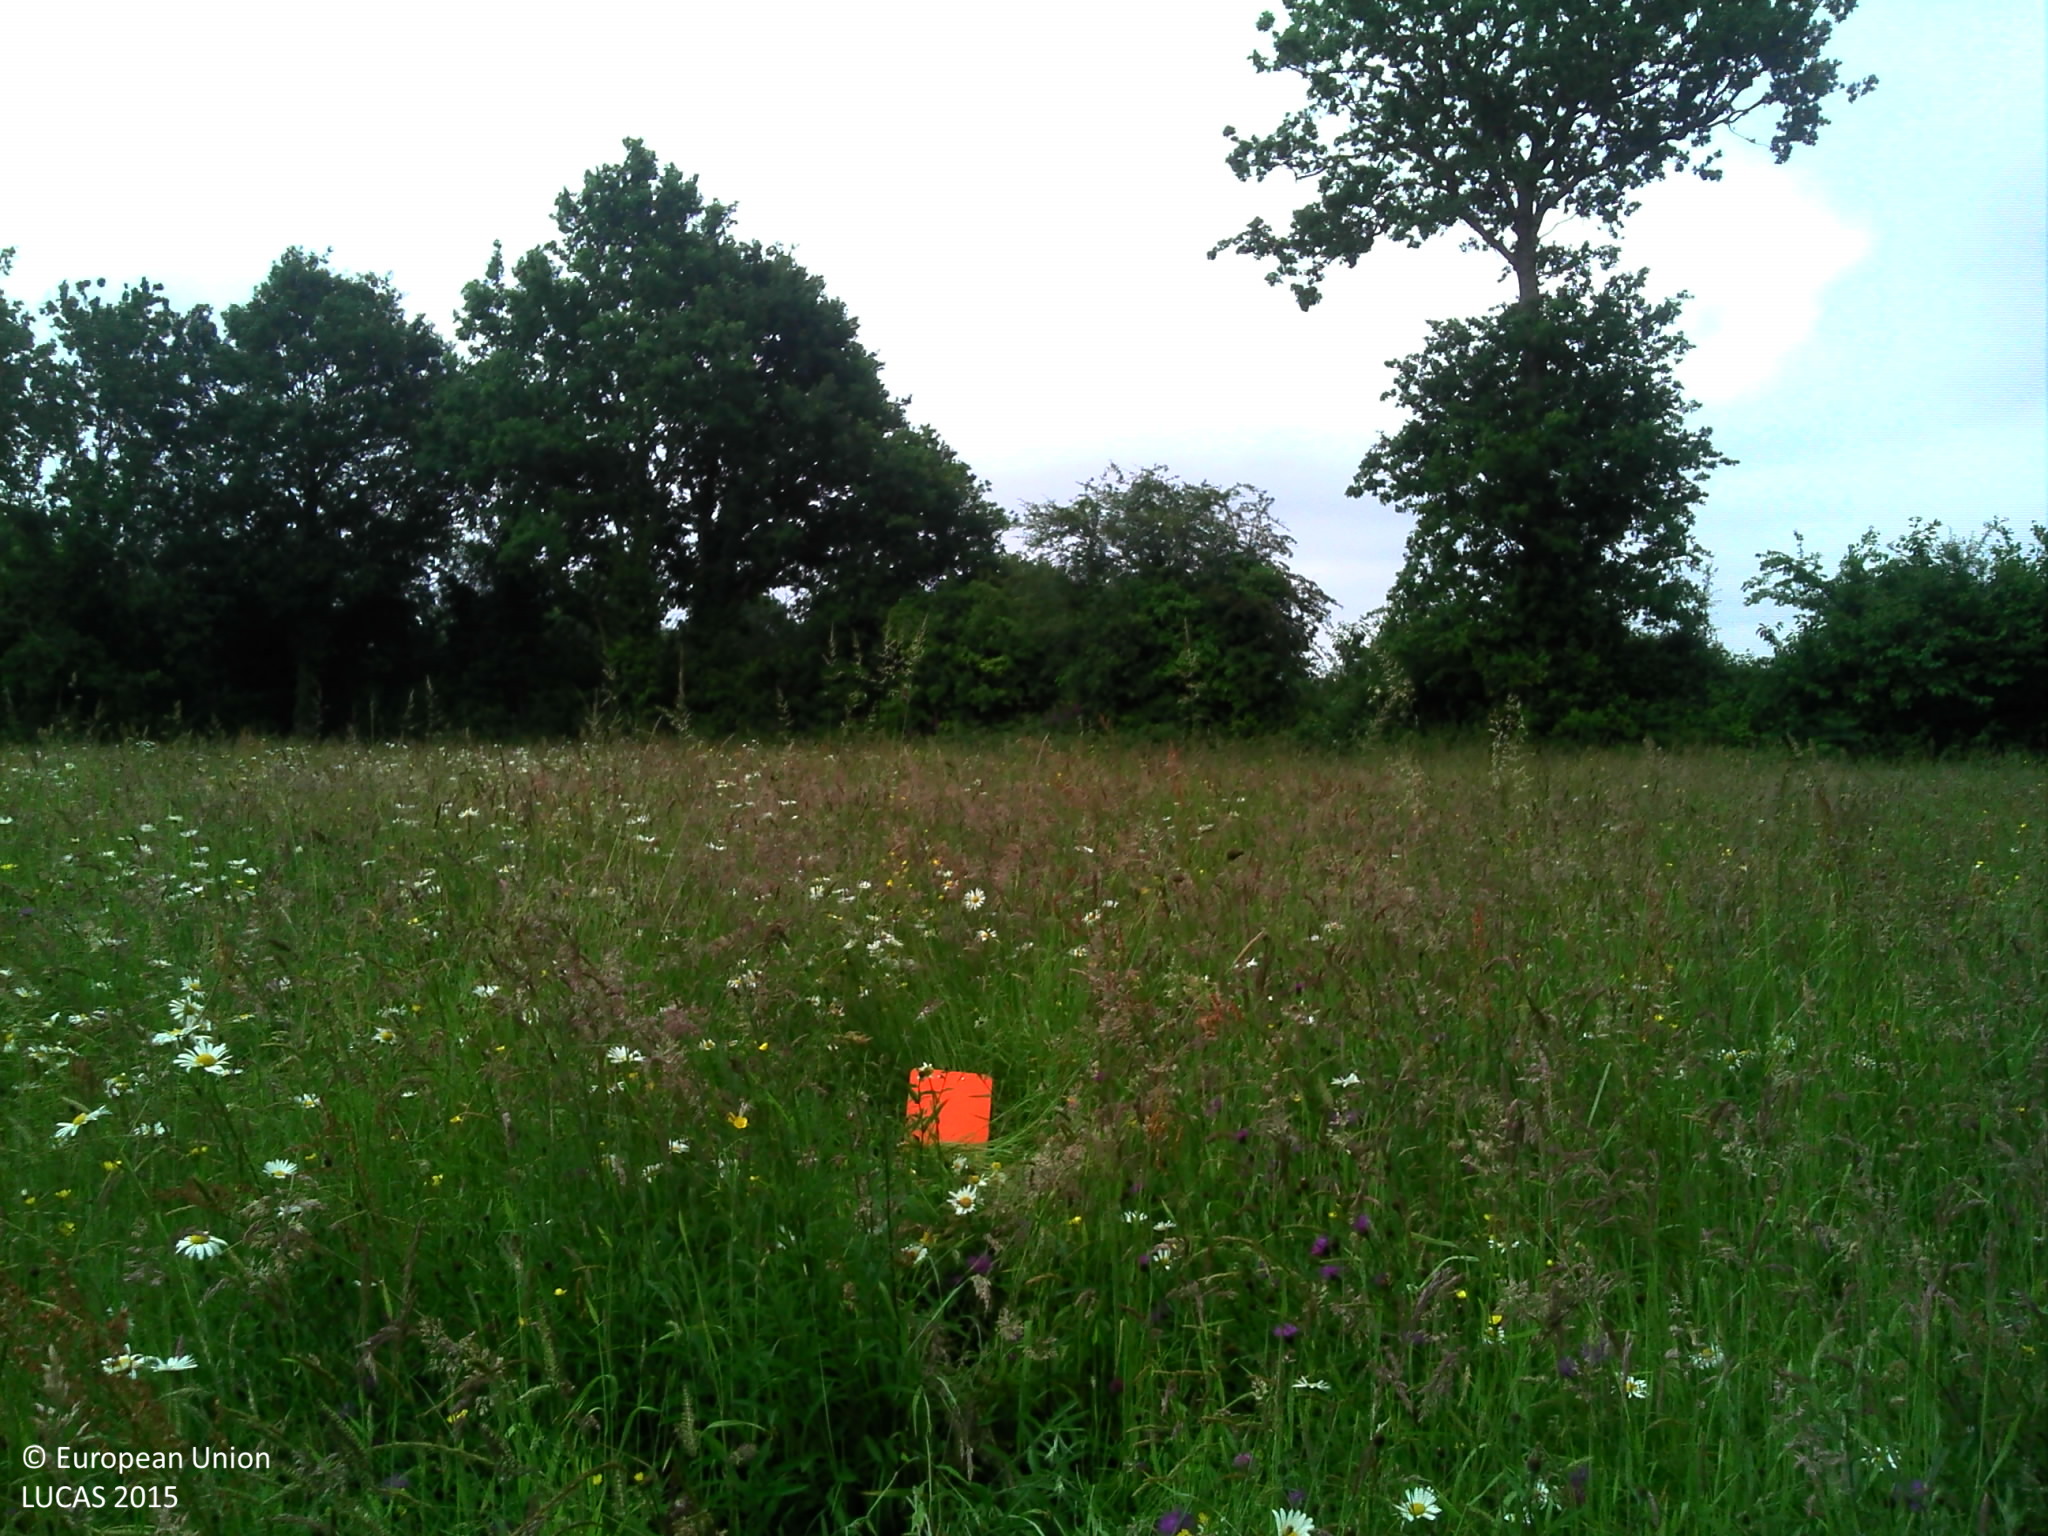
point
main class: Grassland
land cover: Grassland without tree/shrub cover
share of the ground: > 75 %
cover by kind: herbaceous plants 100 %
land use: Agriculture (excluding fallow land and kitchen gardens)
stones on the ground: < 10 %
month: June
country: FR
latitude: 49.3648
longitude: -1.4919
